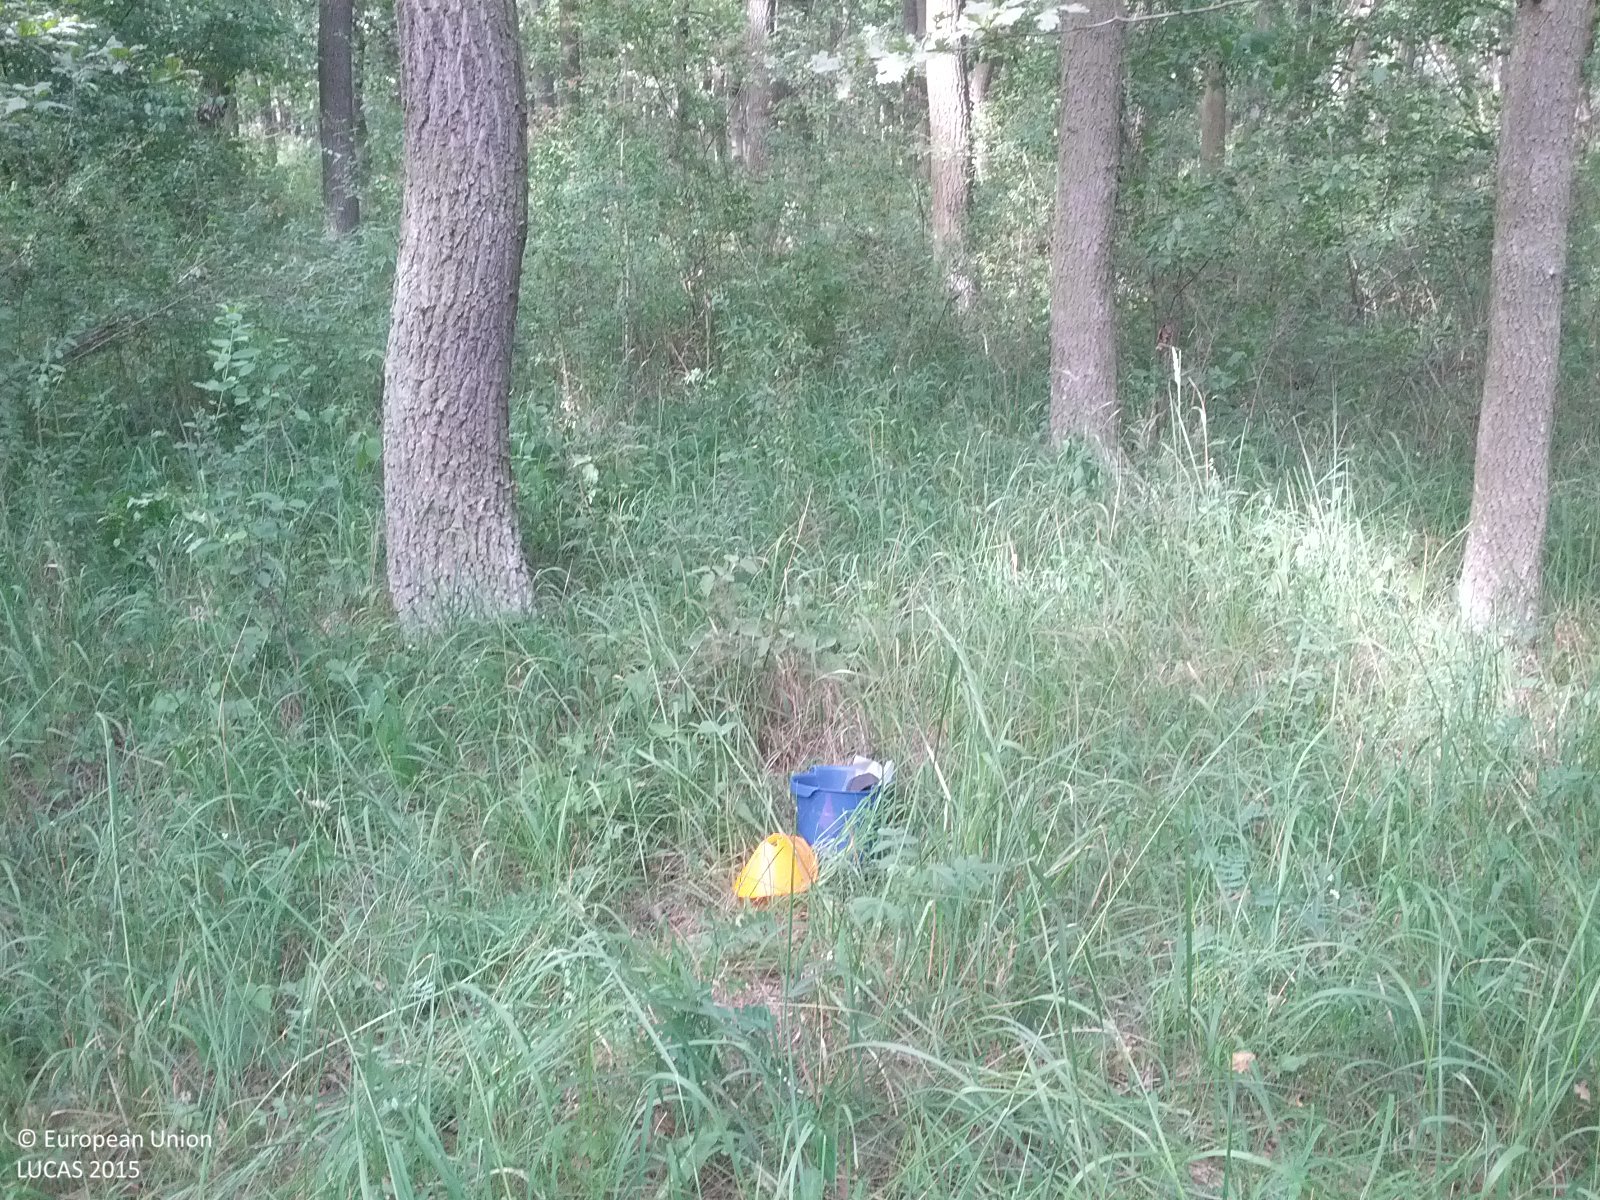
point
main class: Woodland
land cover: Broadleaved woodland
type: mesophytic deciduous forest
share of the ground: 50 - 75 %
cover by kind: broadleaved forest trees 60 %, herbaceous plants 25 %, shrubs 15 %
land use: Forestry
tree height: > 5 m
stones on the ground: < 10 %
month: June
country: AT
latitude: 48.2869
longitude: 16.7588
